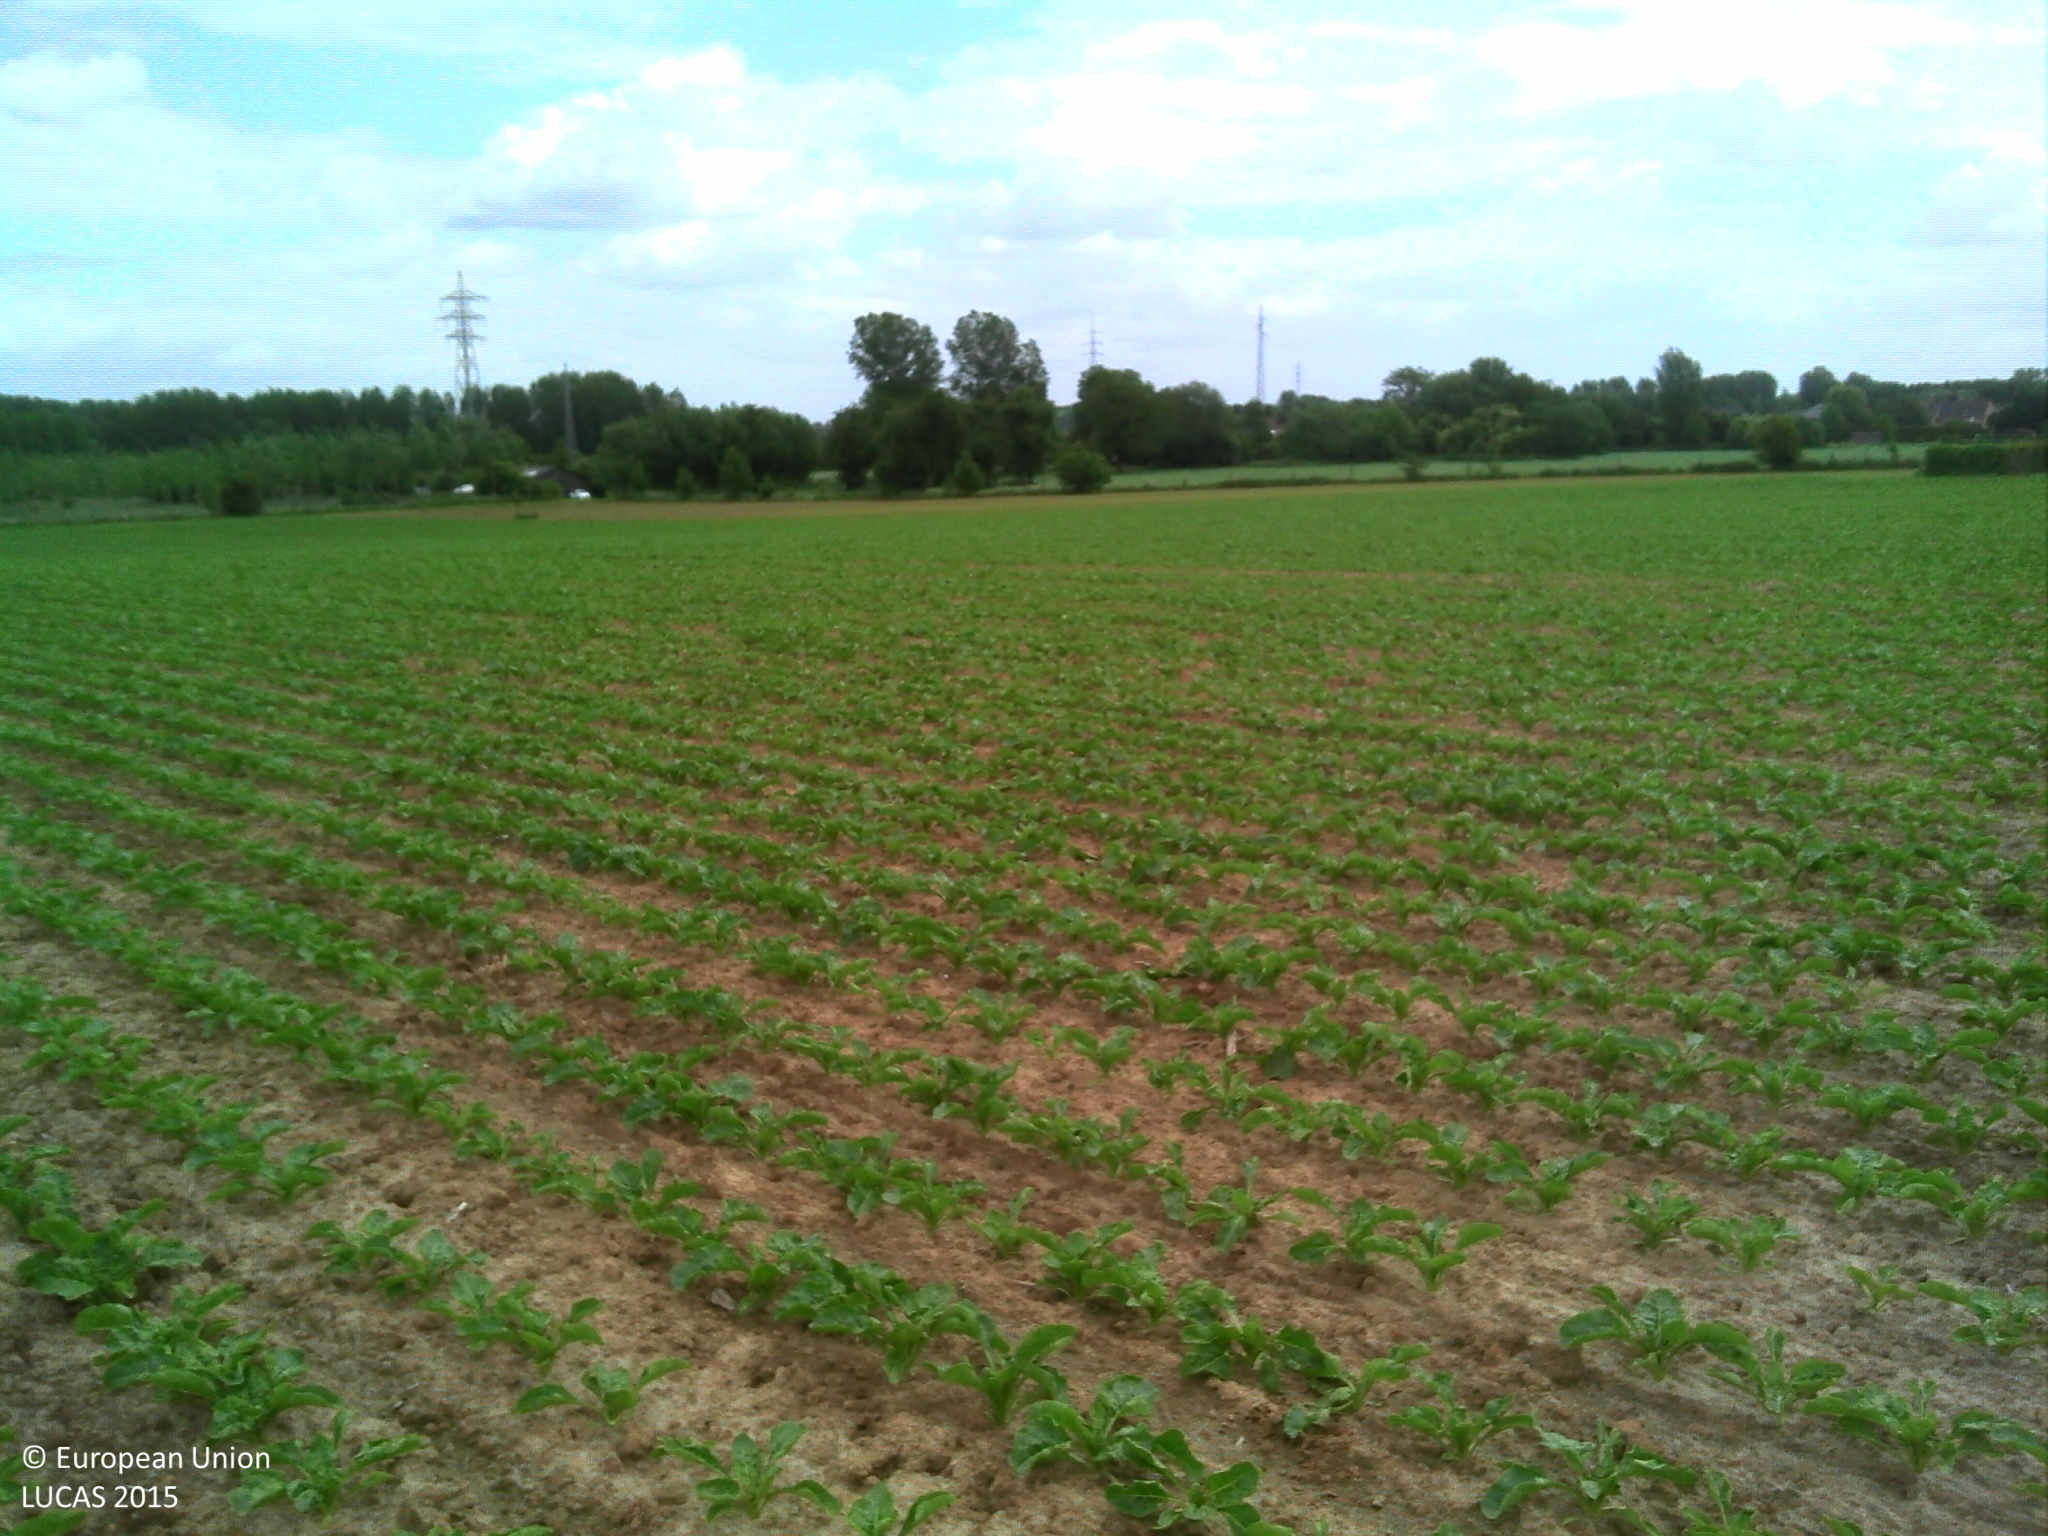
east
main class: Cropland
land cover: Sugar beet
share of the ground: 50 - 75 %
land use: Agriculture (excluding fallow land and kitchen gardens)
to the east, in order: Sugar beet; Maize; Grass margins; Fences; Grassland with sparse tree/shrub cover
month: June
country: BE
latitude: 50.8564
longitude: 4.0136
